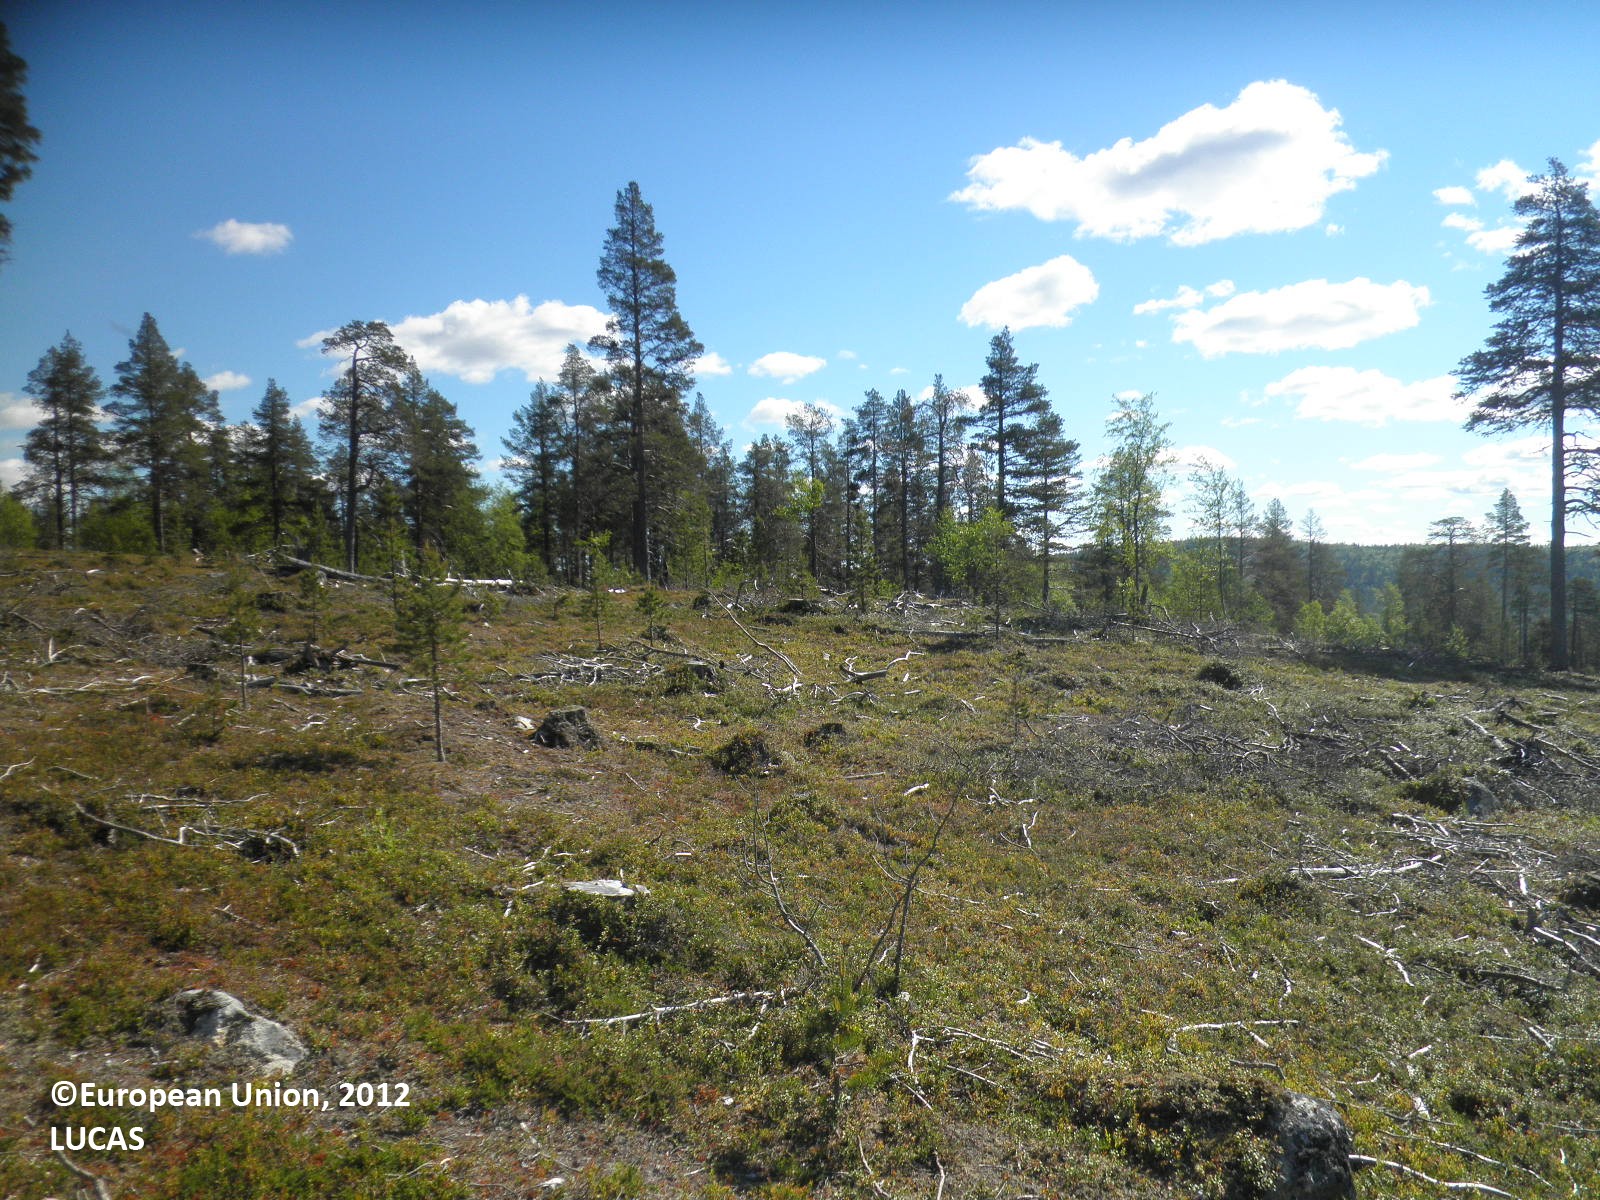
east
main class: Shrubland
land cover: Shrubland with sparse tree cover
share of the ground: 50 - 75 %
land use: Forestry
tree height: < 5 m
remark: Clear cut
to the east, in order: Shrubland with sparse tree cover; Pine dominated mixed woodland
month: July
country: FI
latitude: 68.7971
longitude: 26.6271
